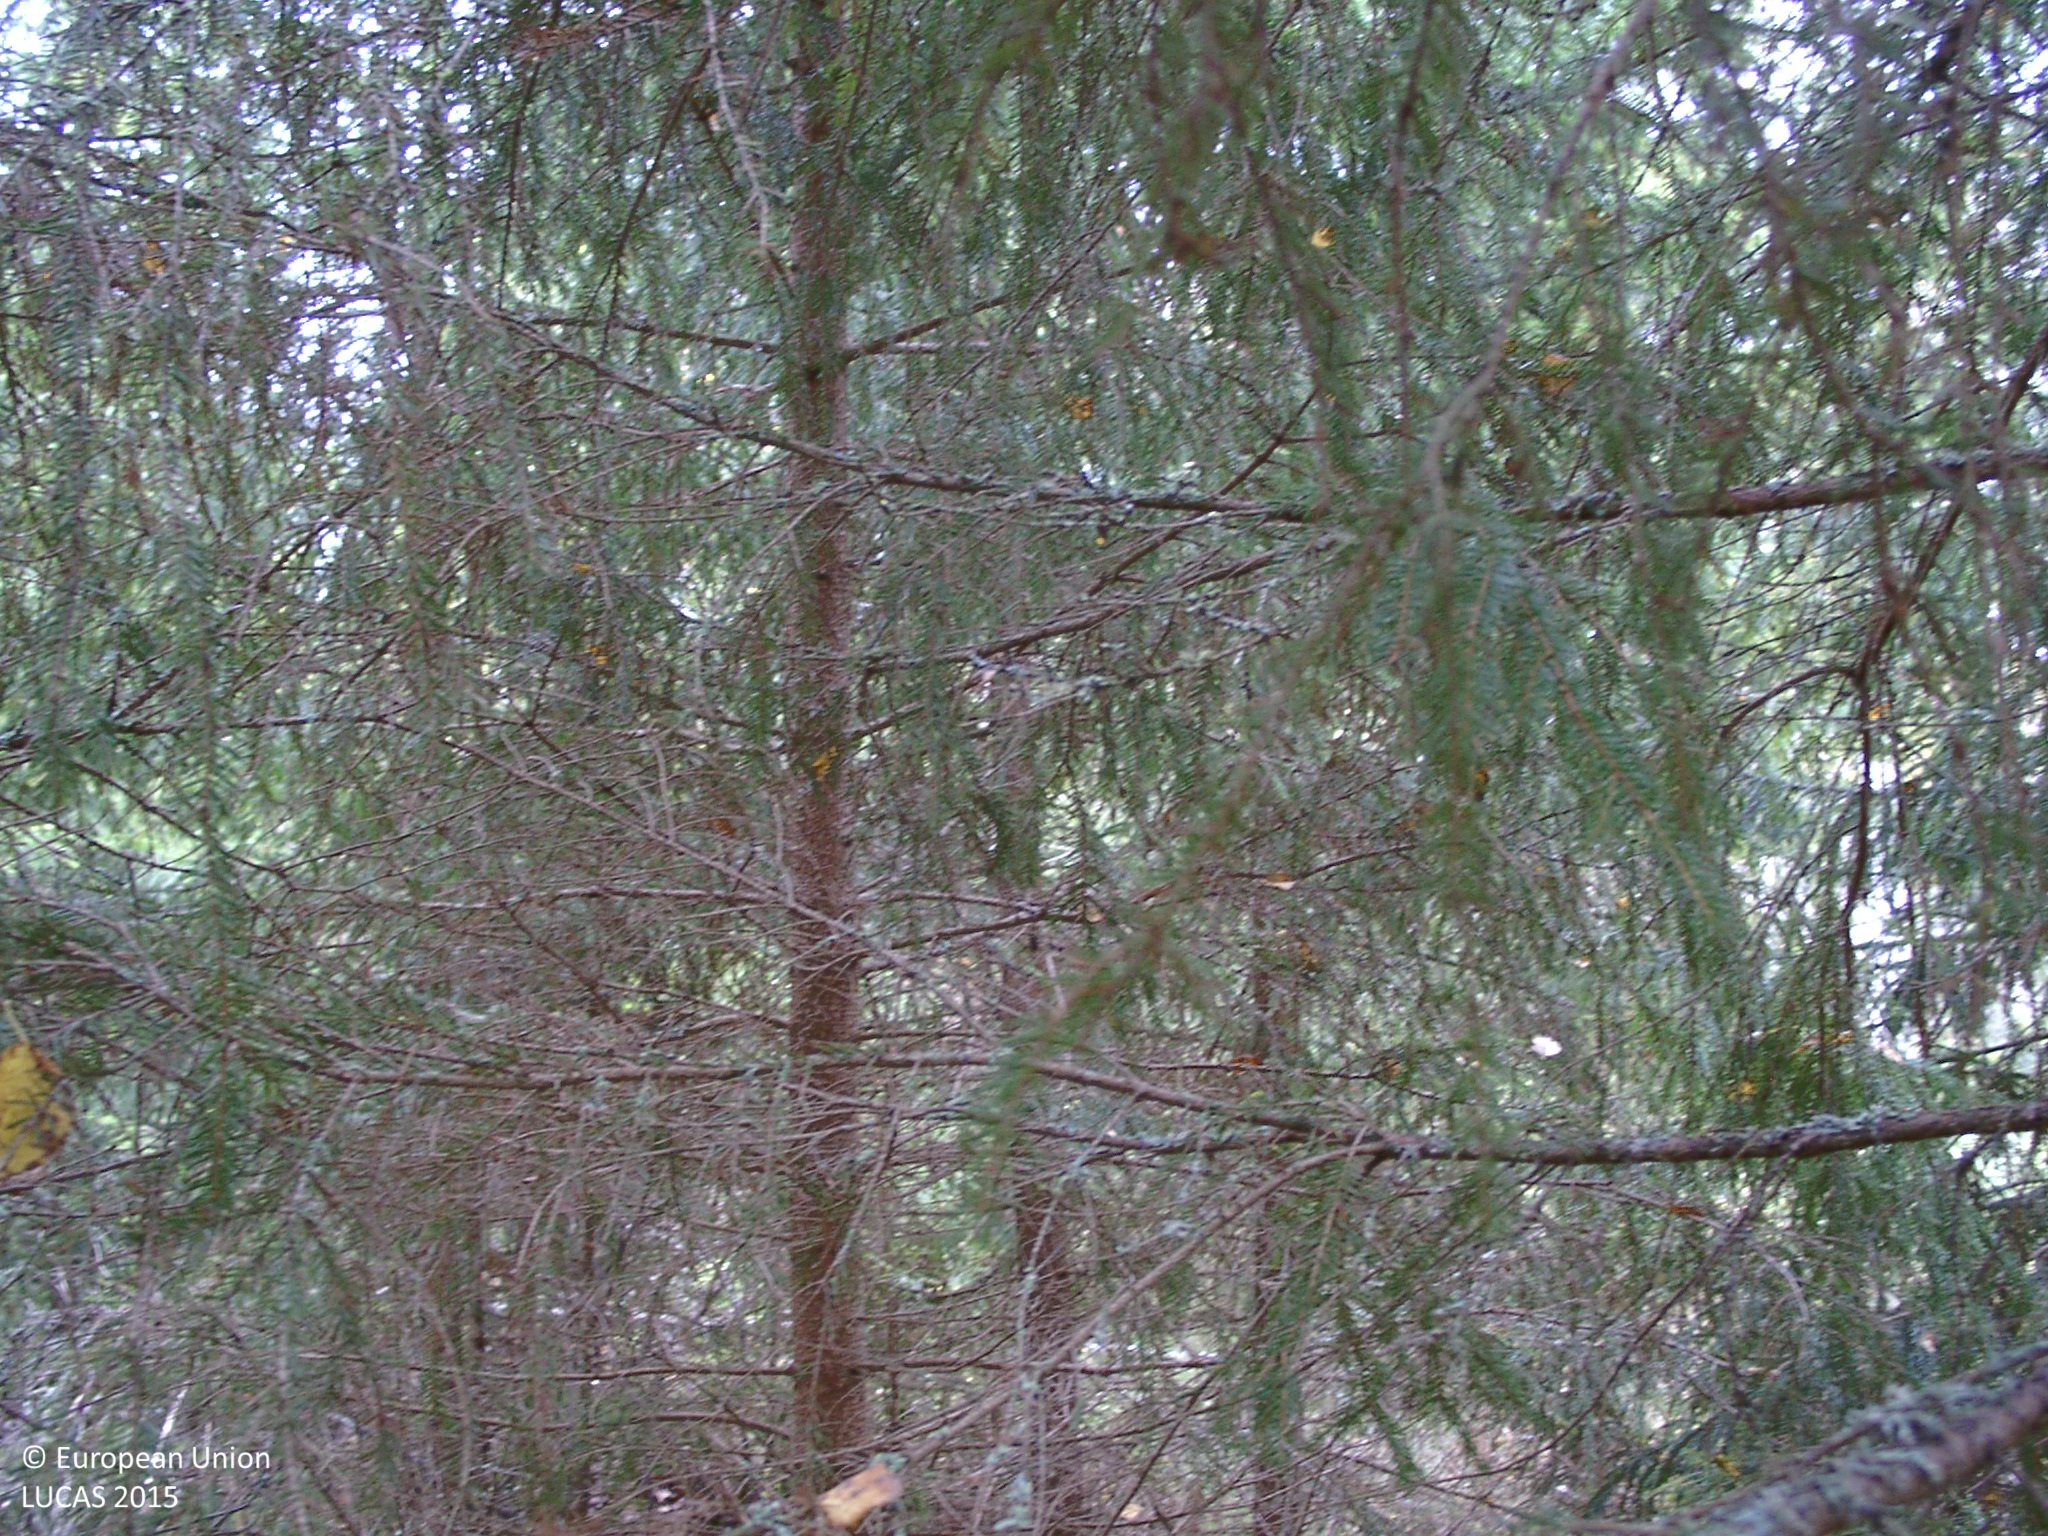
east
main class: Woodland
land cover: Spruce dominated coniferous woodland
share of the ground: > 75 %
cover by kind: coniferous forest trees 85 %, shrubs 5 %, herbaceous plants 5 %, lichens and mosses 5 %
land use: Forestry
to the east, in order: Spruce dominated coniferous woodland; Broadleaved woodland; Spruce dominated coniferous woodland; Tracks; Spruce dominated coniferous woodland; Spruce dominated mixed woodland; Ditches and canals
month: September
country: FI
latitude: 62.6312
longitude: 25.3347
